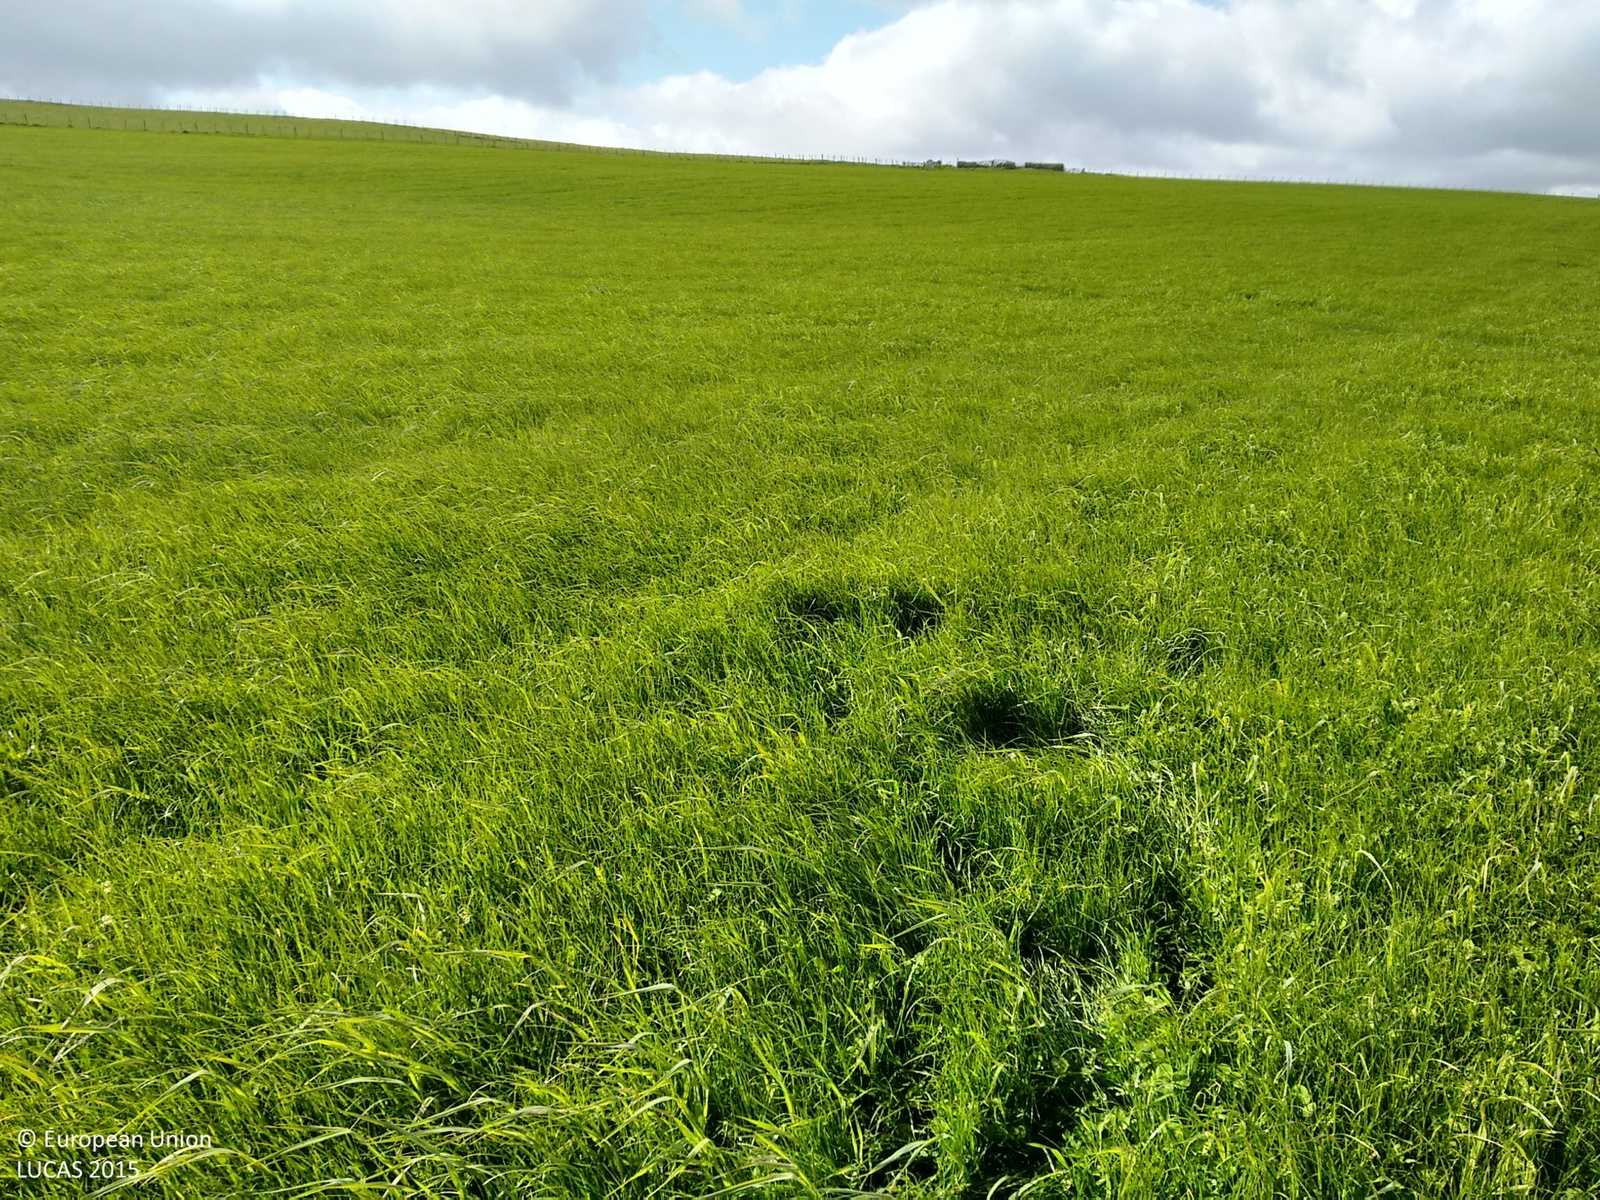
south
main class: Grassland
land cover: Grassland without tree/shrub cover
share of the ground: > 75 %
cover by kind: herbaceous plants 100 %
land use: Agriculture (excluding fallow land and kitchen gardens)
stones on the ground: < 10 %
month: June
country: GB
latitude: 55.4010
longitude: -2.5851
